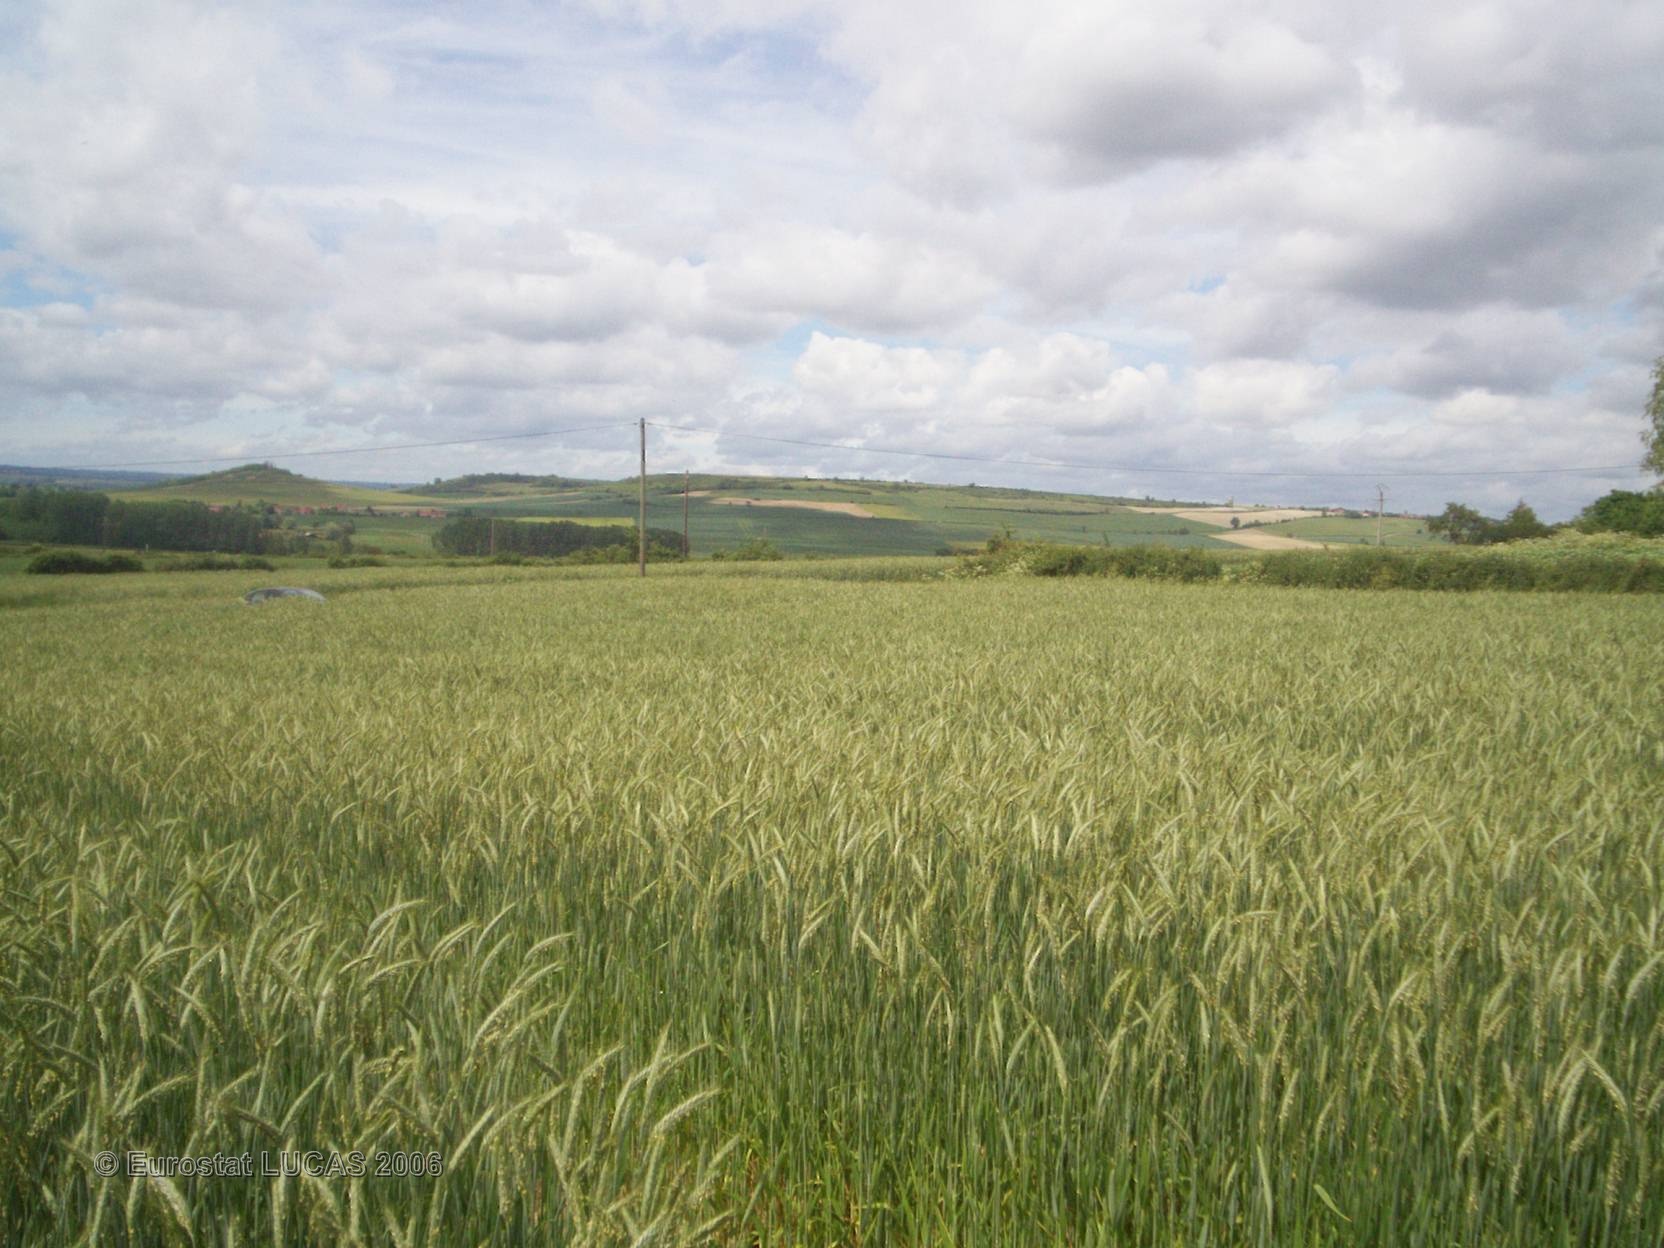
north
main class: Cropland
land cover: Triticale
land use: Agriculture (excluding fallow land and kitchen gardens)
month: May
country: FR
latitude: 46.1496
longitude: 3.1496
